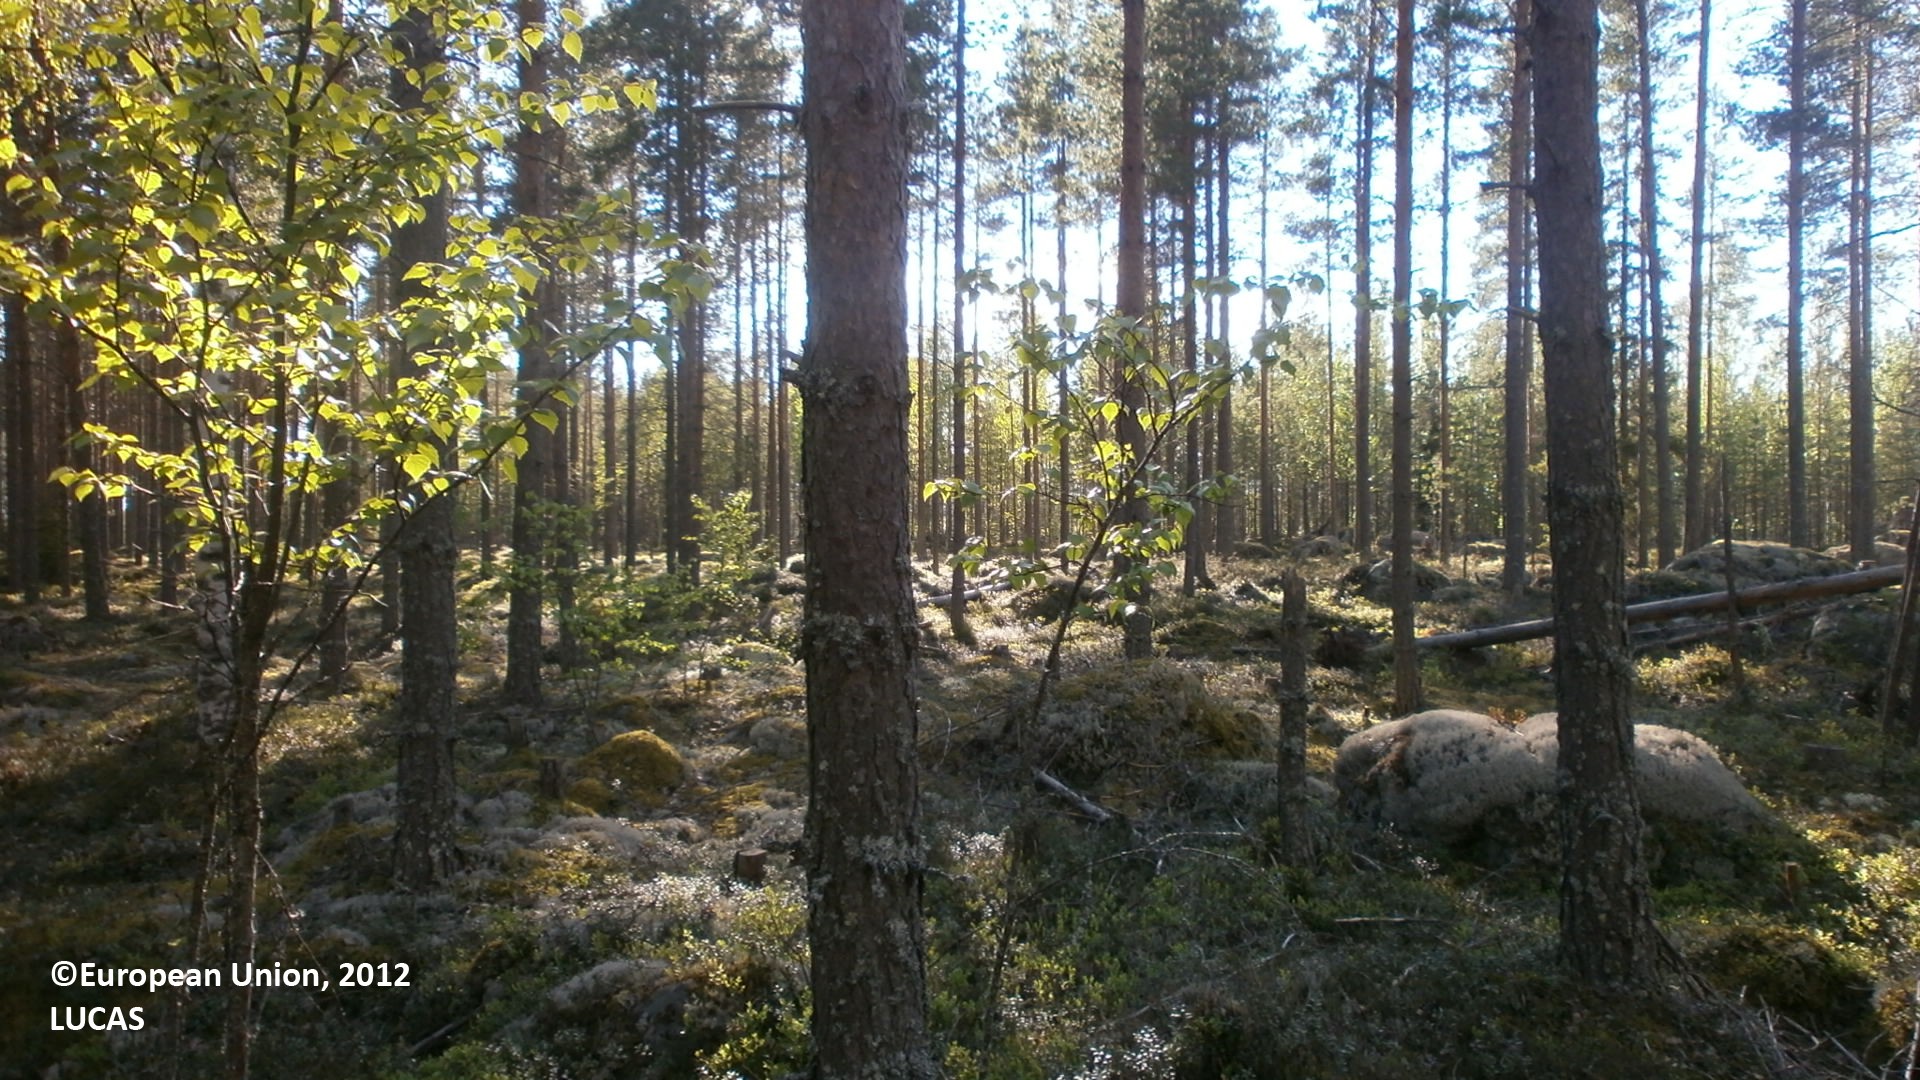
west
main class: Woodland
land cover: Pine dominated coniferous woodland
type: hemiboreal forest and nemoral coniferous forest and mixed broadleaved-coniferous forest
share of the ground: 25 - 50 %
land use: Forestry
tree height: > 5 m
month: June
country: FI
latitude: 64.5540
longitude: 25.1208
